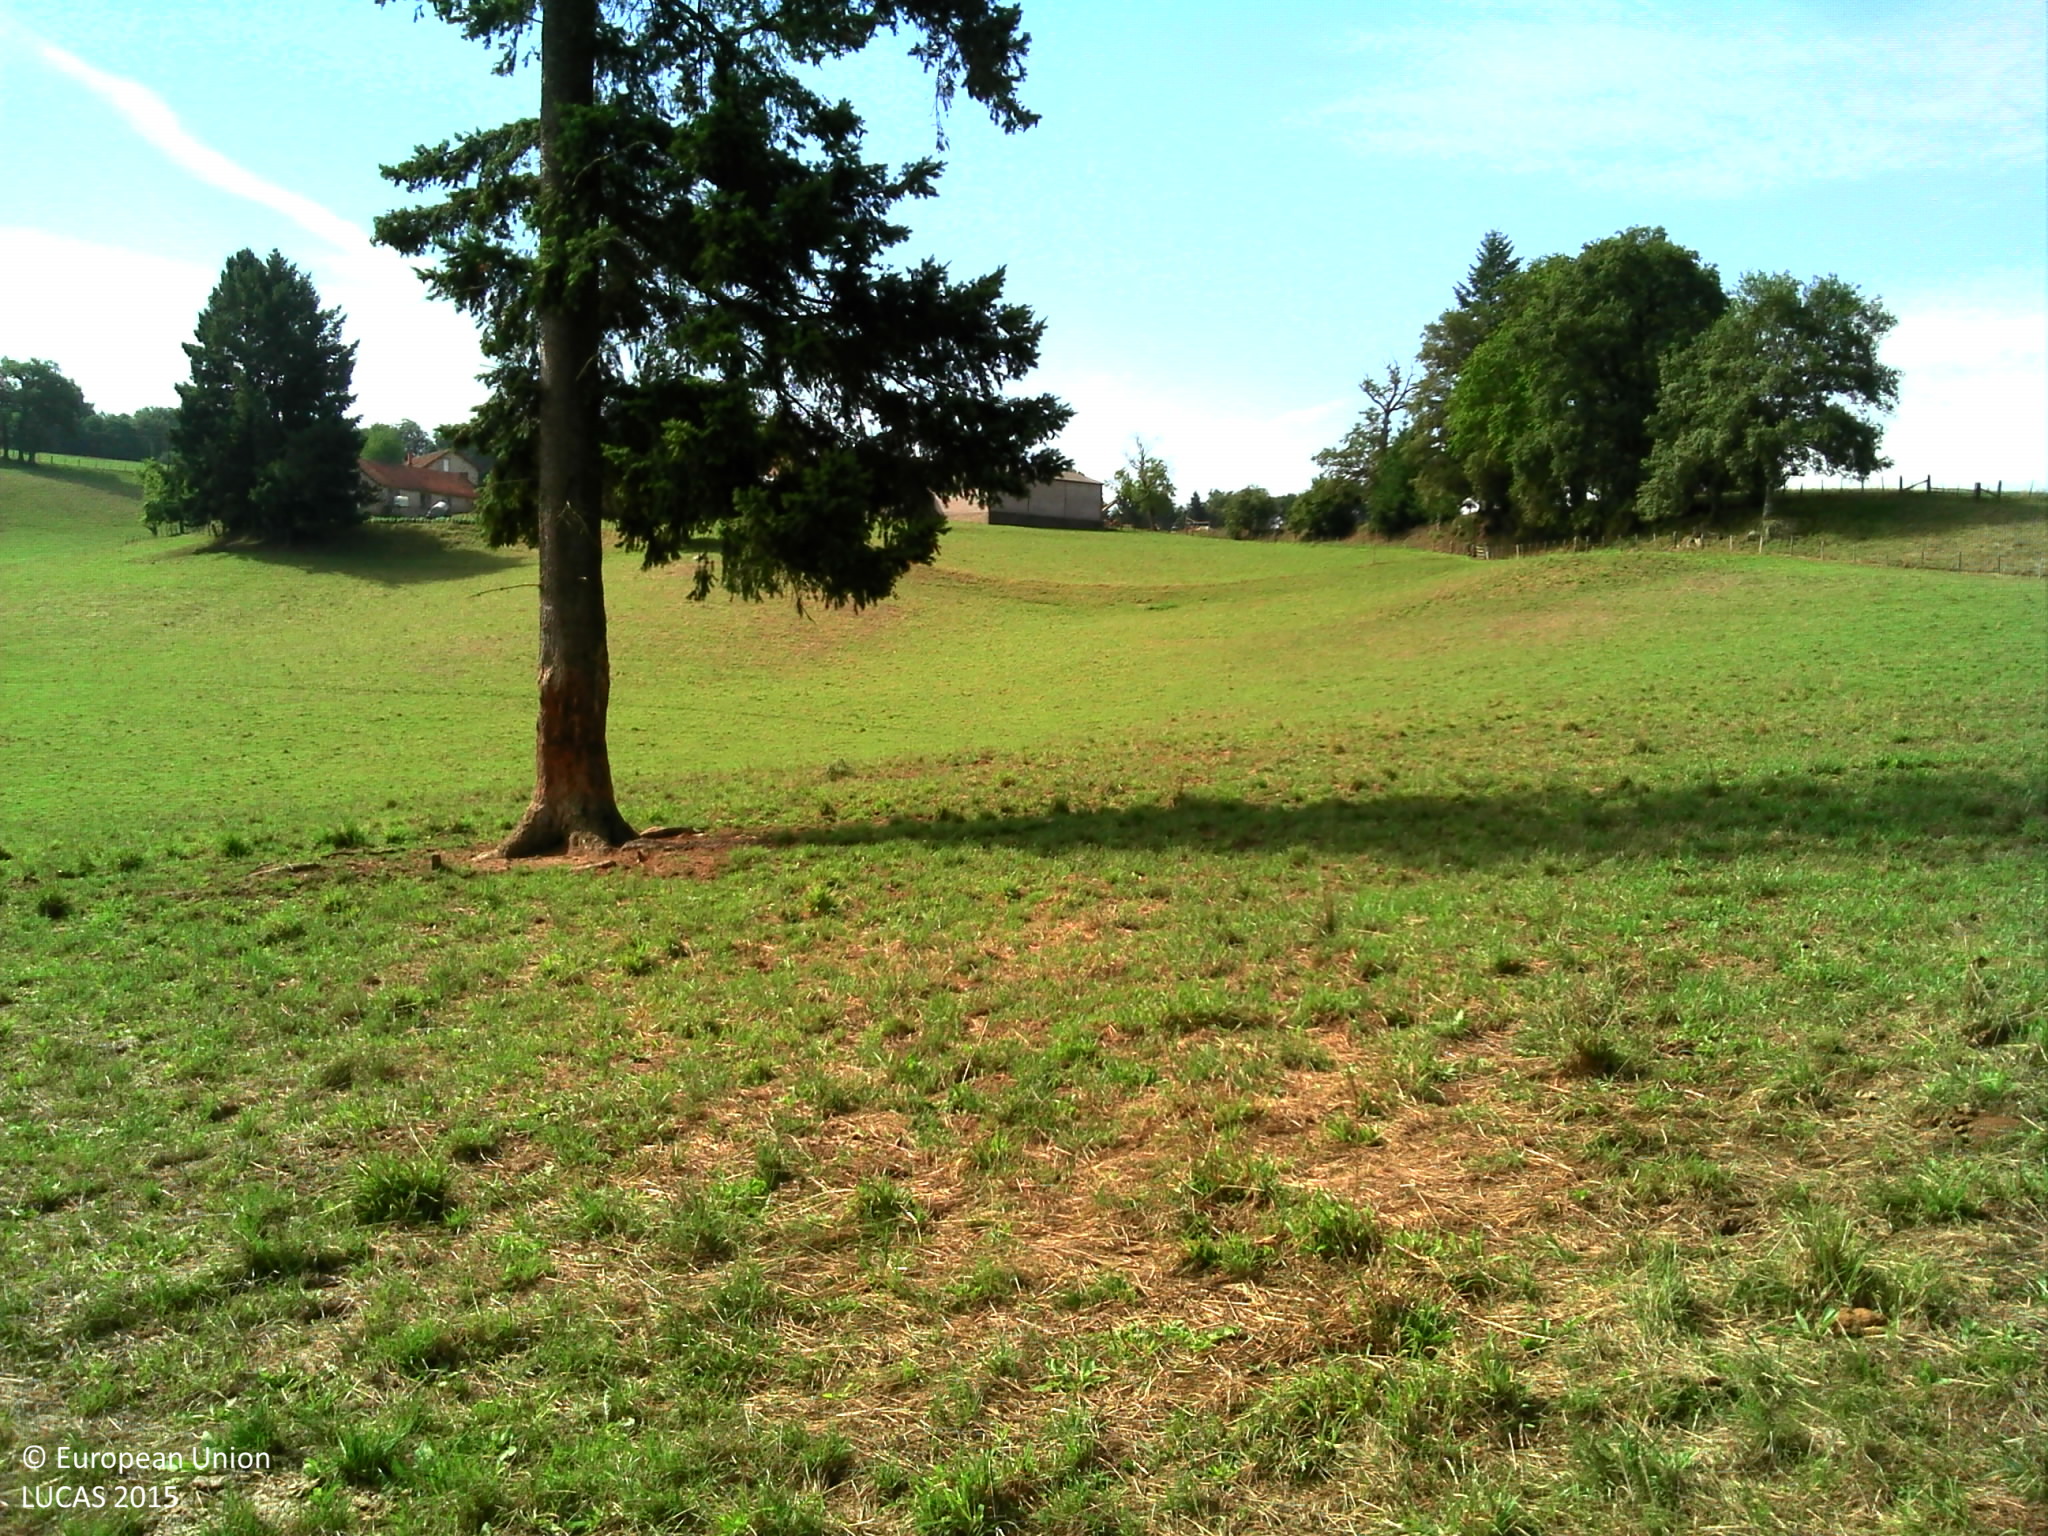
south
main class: Grassland
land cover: Grassland without tree/shrub cover
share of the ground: > 75 %
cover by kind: herbaceous plants 95 %
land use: Agriculture (excluding fallow land and kitchen gardens)
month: August
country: FR
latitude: 45.6145
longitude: 1.2846
